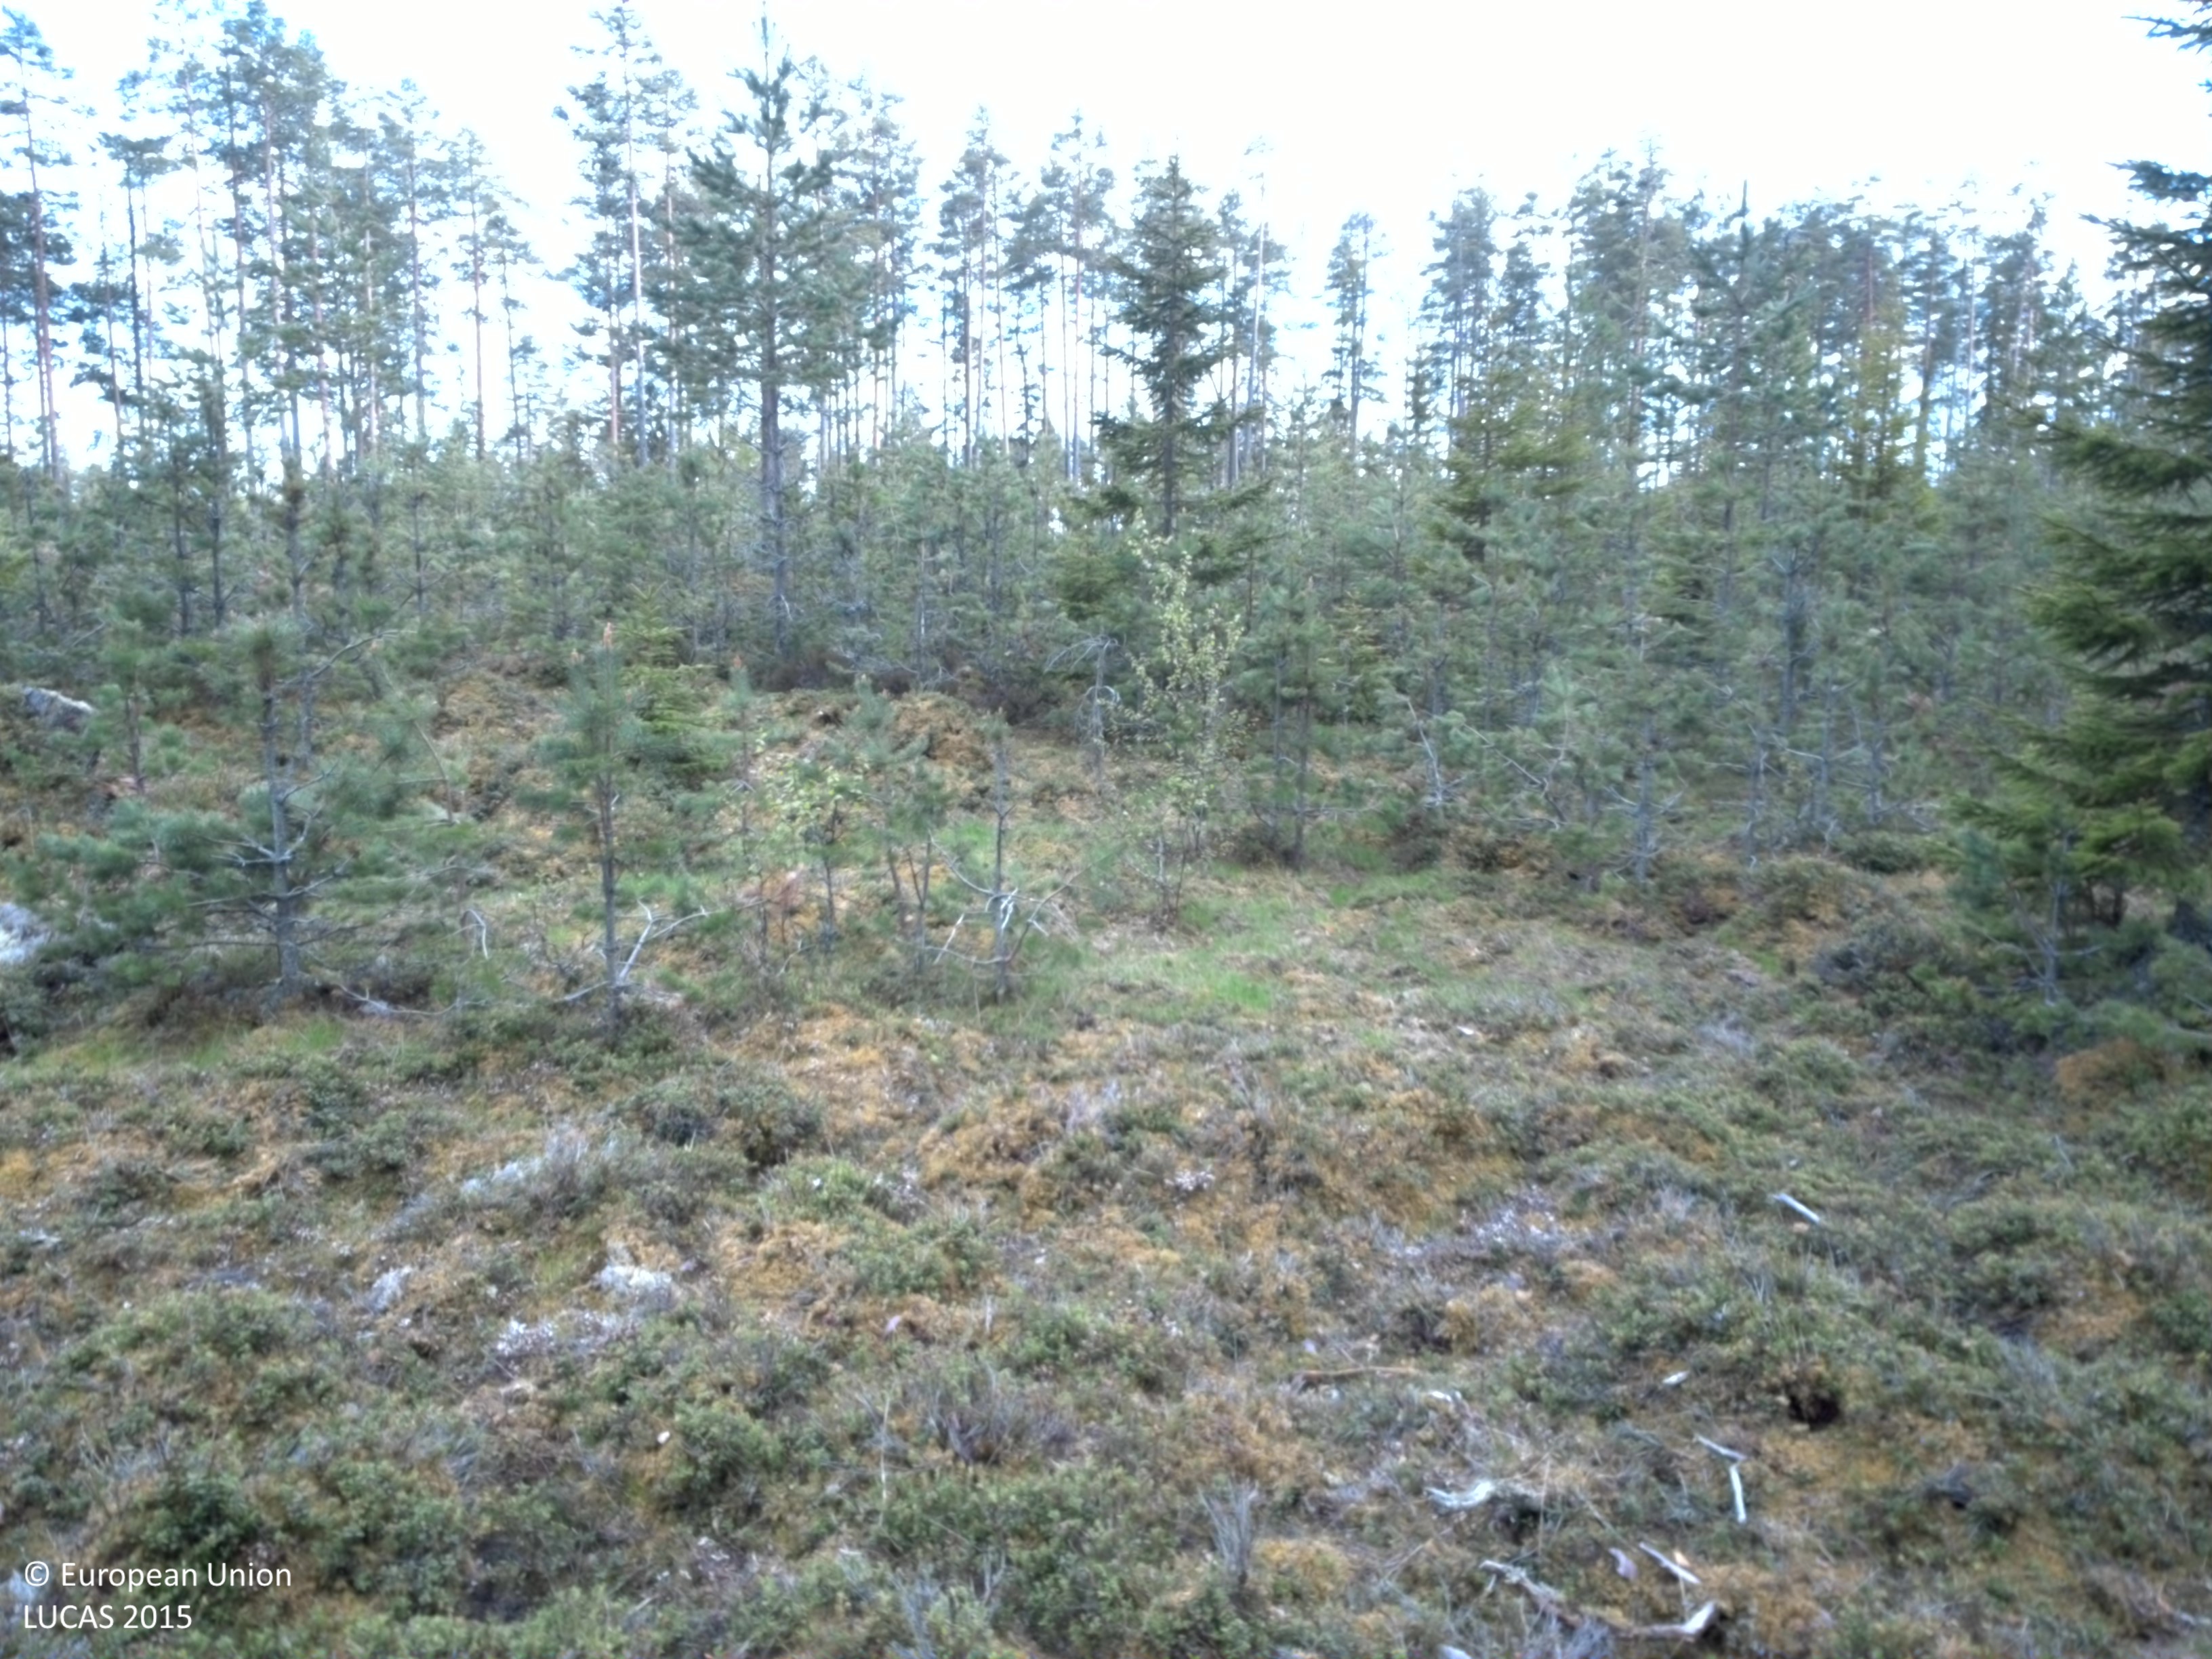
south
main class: Woodland
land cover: Pine dominated coniferous woodland
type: boreal forest
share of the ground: 10 - 25 %
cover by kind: shrubs 70 %, coniferous forest trees 15 %, lichens and mosses 15 %
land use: Forestry
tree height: > 5 m
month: June
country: SE
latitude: 60.5216
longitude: 13.2511
